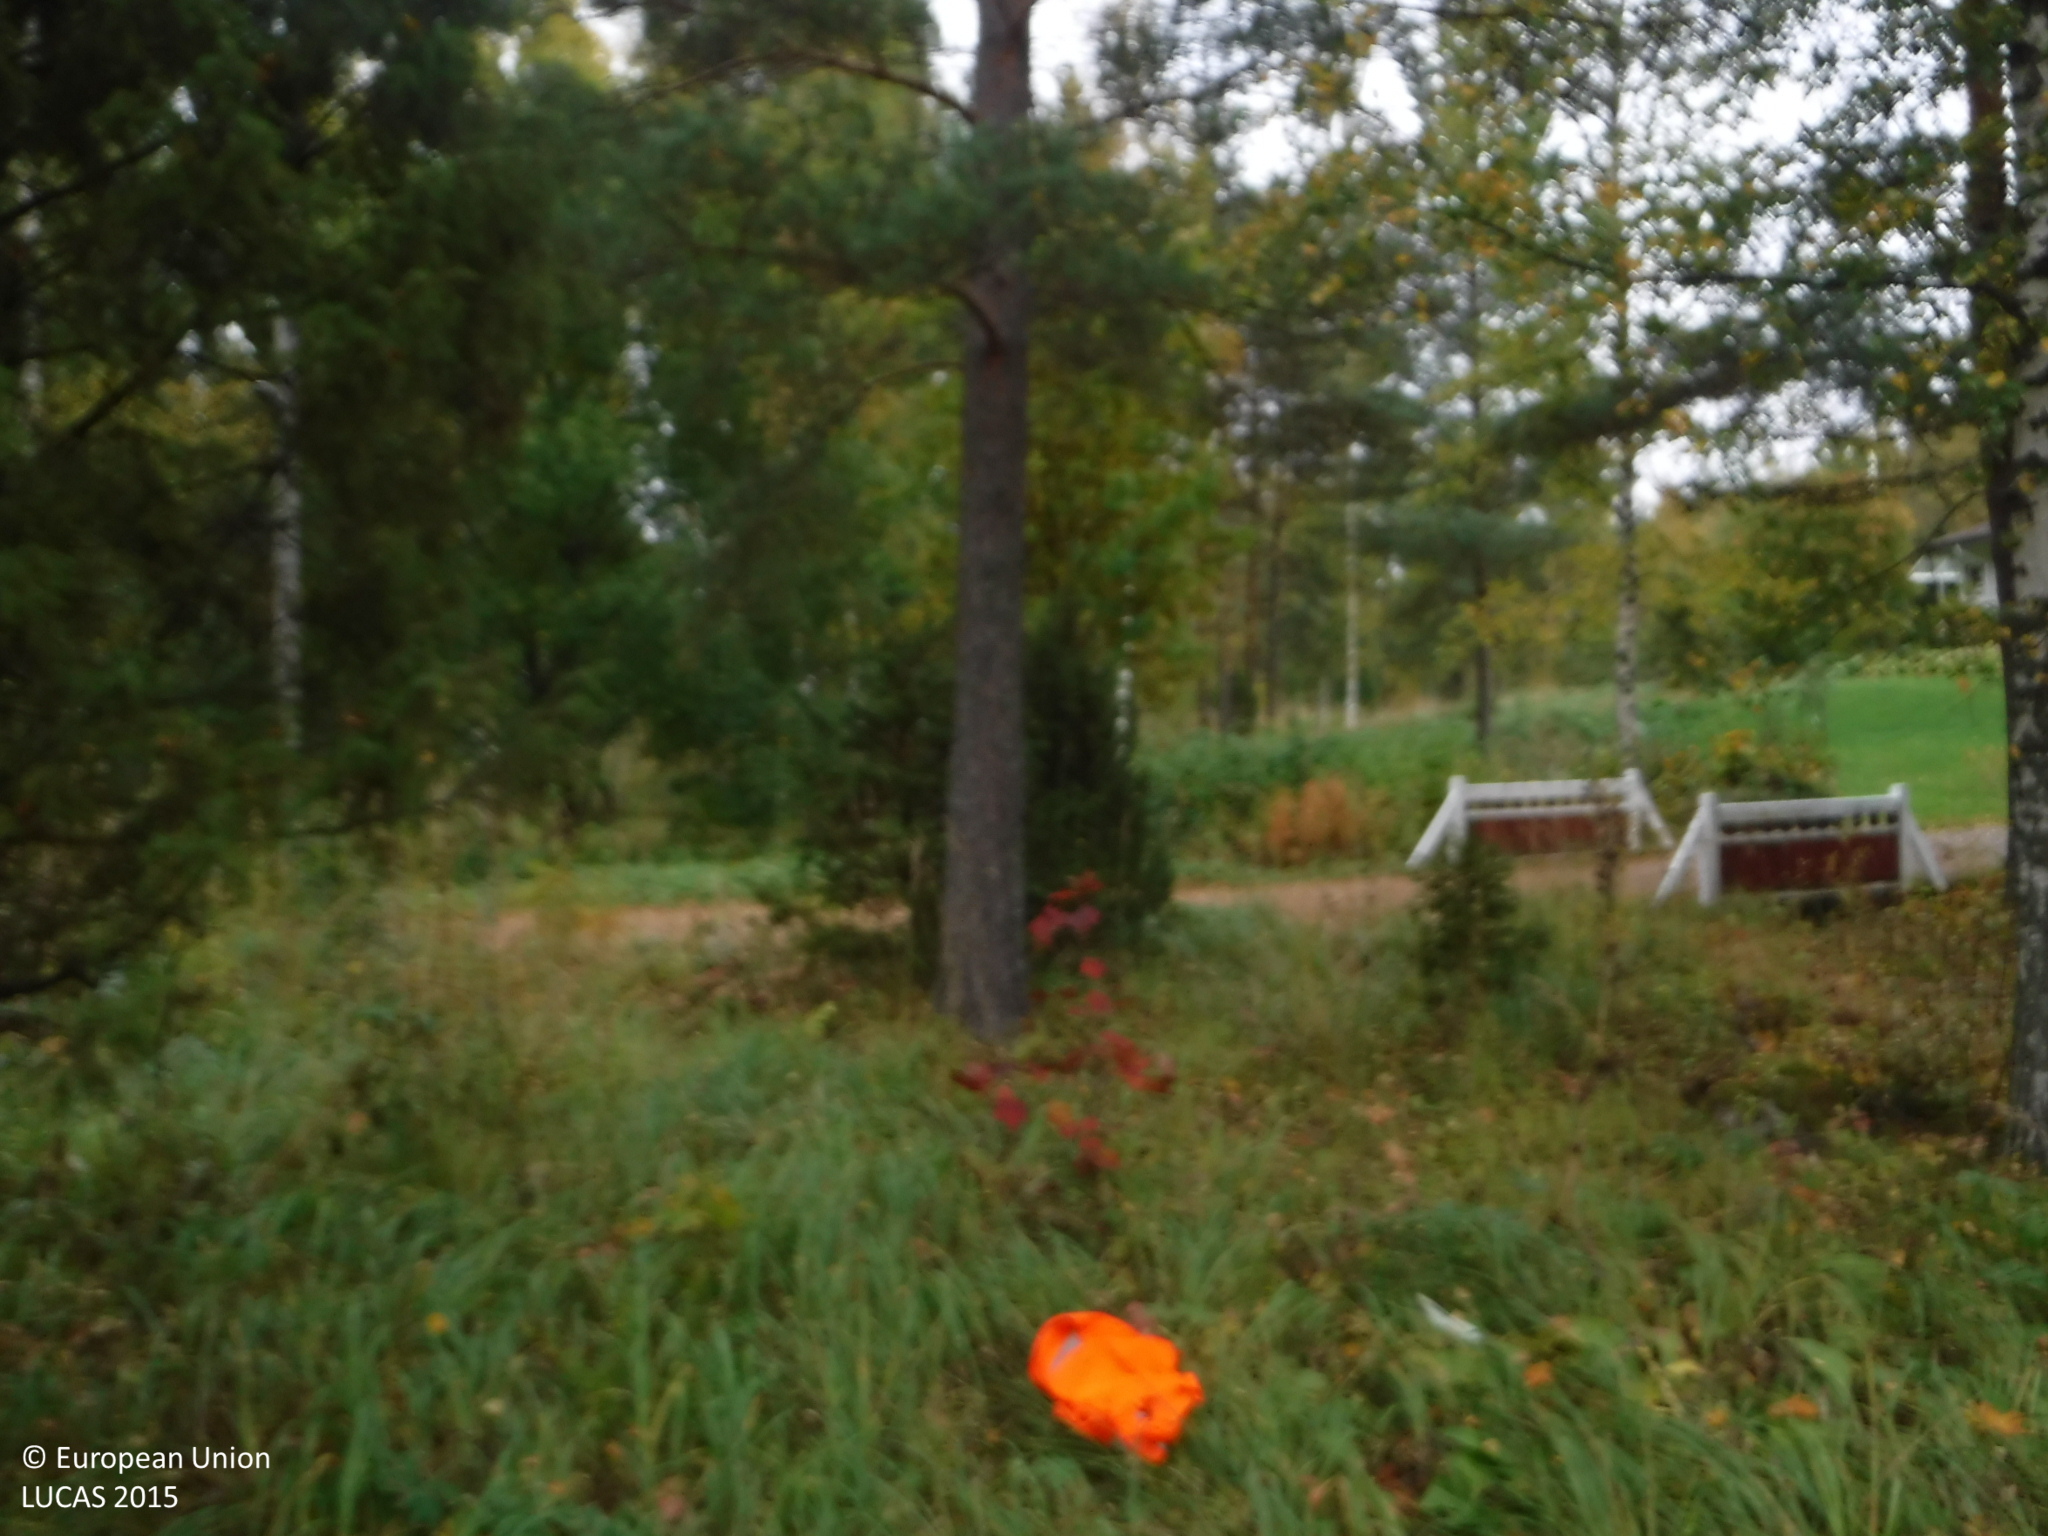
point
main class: Woodland
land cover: Pine dominated mixed woodland
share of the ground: 50 - 75 %
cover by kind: herbaceous plants 50 %, coniferous forest trees 25 %, broadleaved forest trees 25 %
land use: Residential
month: September
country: FI
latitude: 61.5858
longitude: 23.8178
